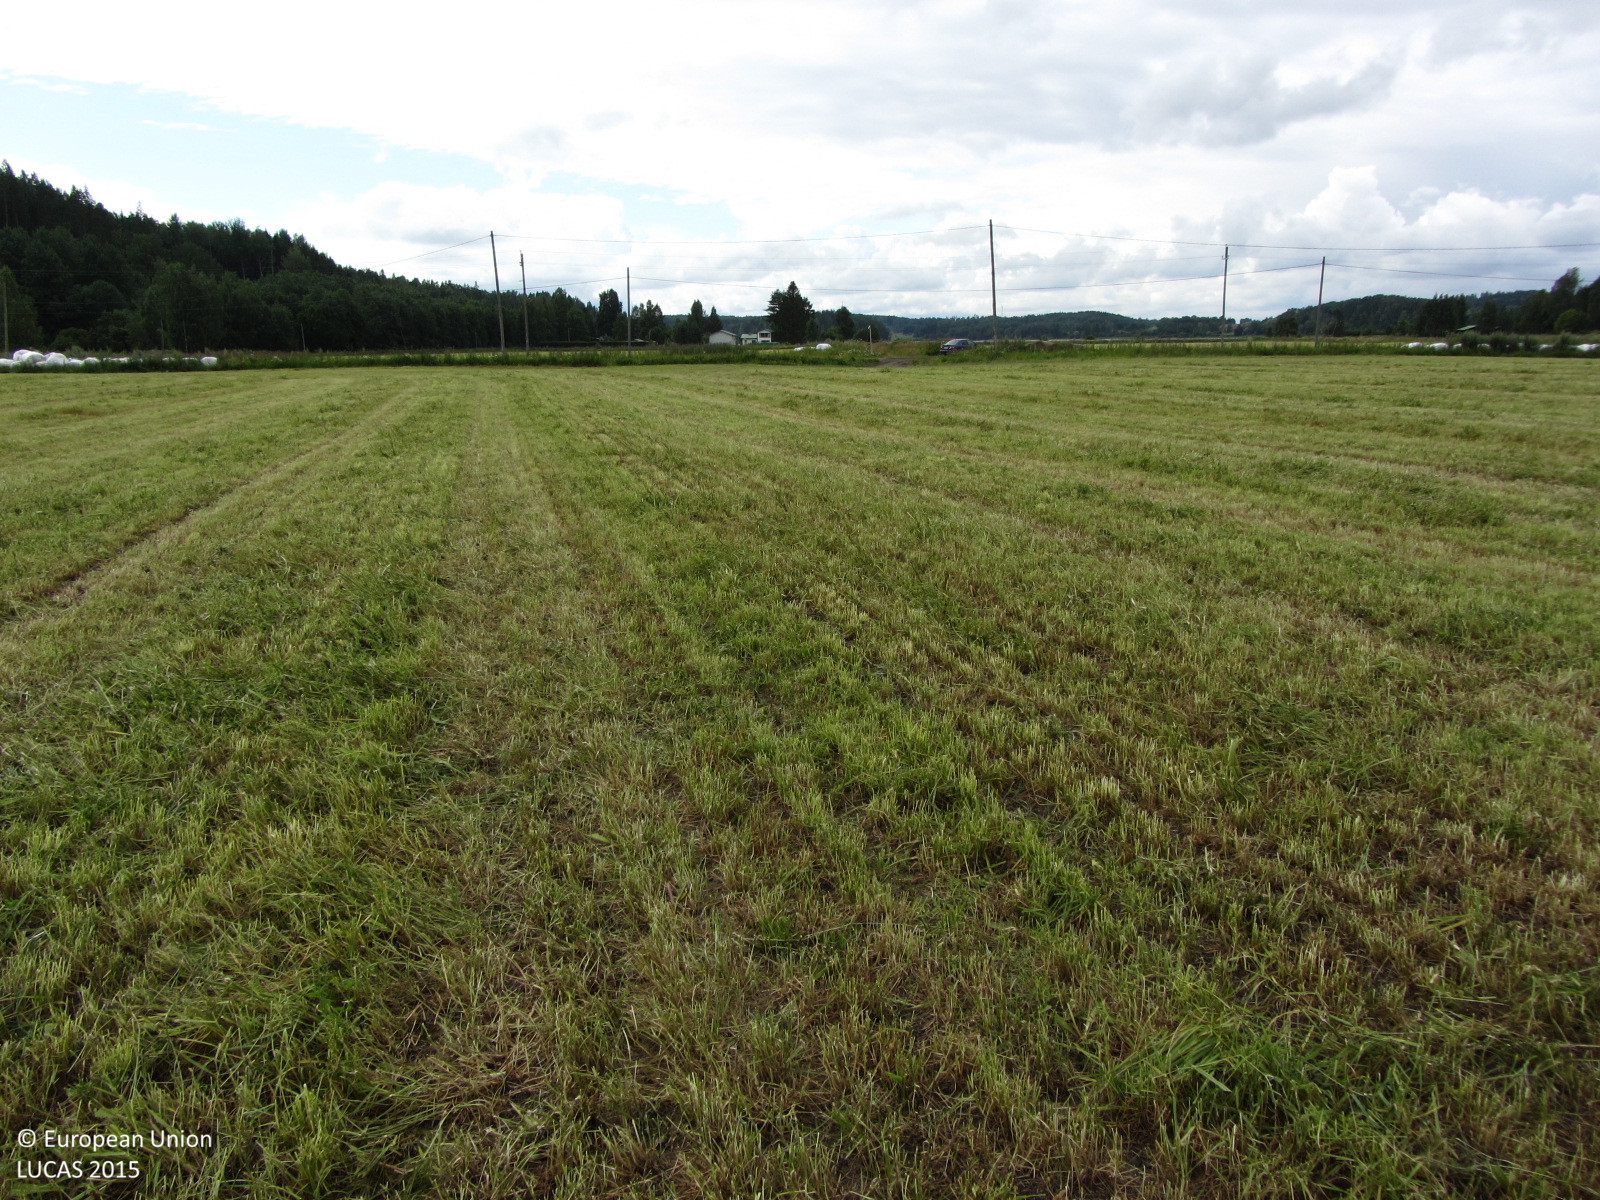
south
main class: Cropland
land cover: Temporary grasslands
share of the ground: > 75 %
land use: Agriculture (excluding fallow land and kitchen gardens)
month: July
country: FI
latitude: 60.4658
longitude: 24.3803
